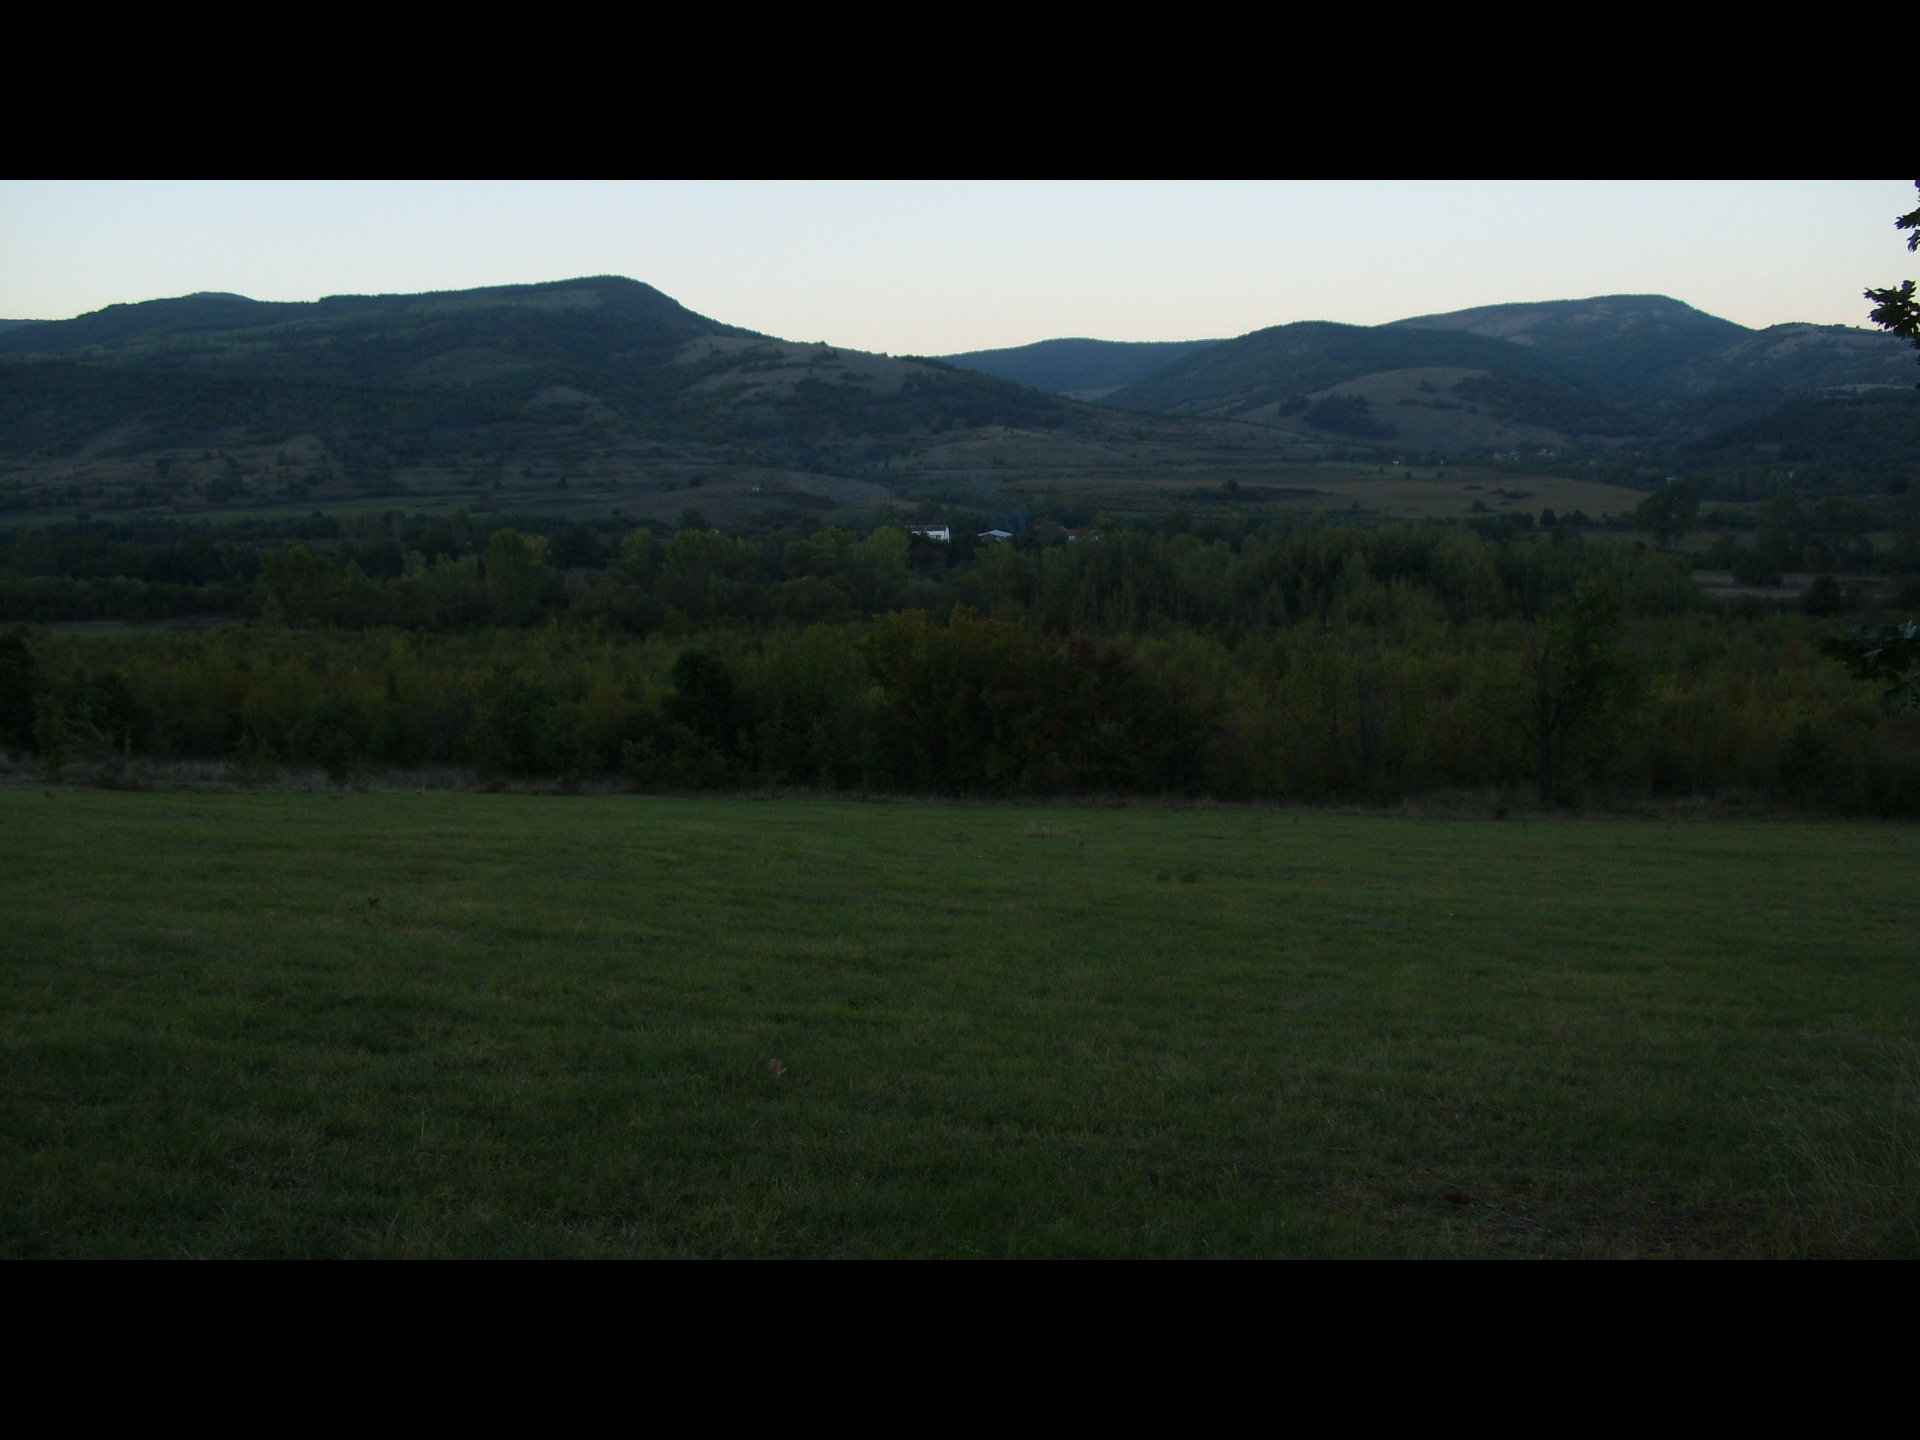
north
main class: Grassland
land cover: Grassland with sparse tree/shrub cover
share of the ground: > 75 %
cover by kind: herbaceous plants 85 %, shrubs 10 %, broadleaved forest trees 5 %
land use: Agriculture (excluding fallow land and kitchen gardens)
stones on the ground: < 10 %
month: October
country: BG
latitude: 43.4203
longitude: 22.9928
